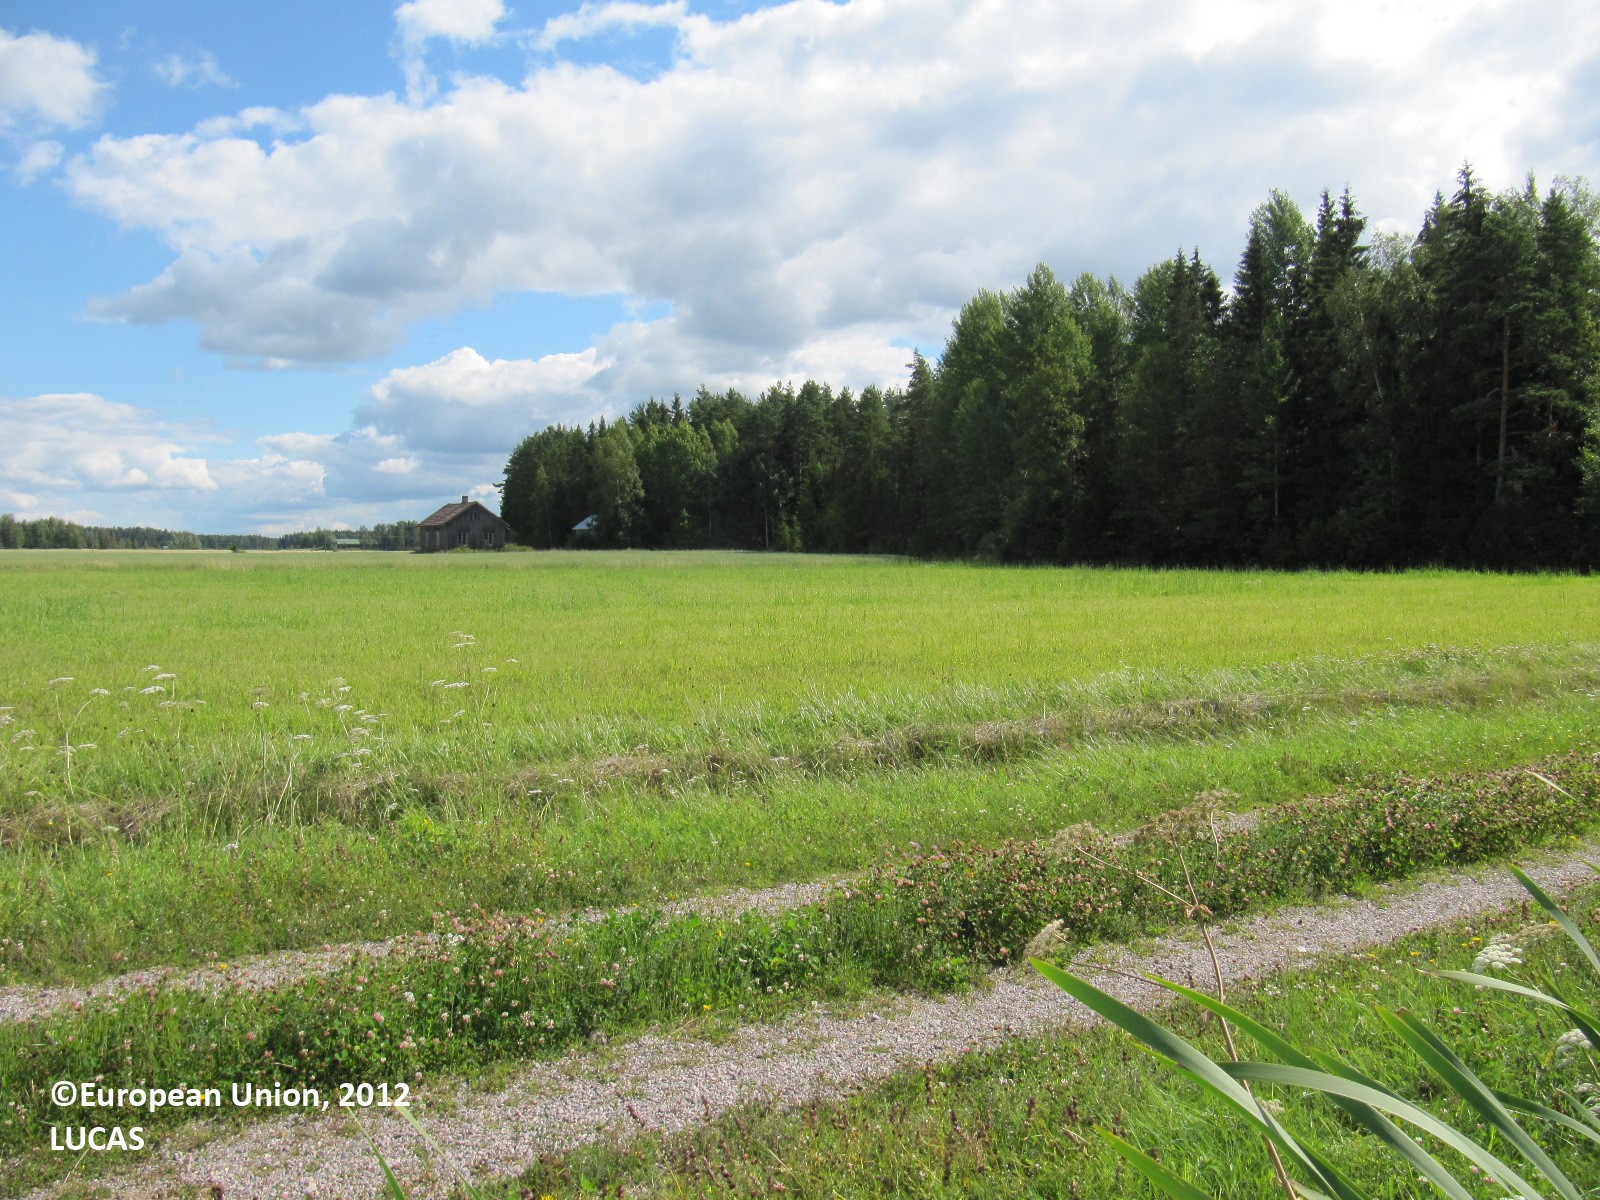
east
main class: Cropland
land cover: Barley
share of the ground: > 75 %
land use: Agriculture (excluding fallow land and kitchen gardens)
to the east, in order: Barley; Electric lines; Barley; Grass margins; Ditches and canals; Grass margins; Tracks; Grass margins; Ditches and canals; Grassland without tree/shrub cover; Ditches and canals; Broadleaved woodland; Pine dominated mixed woodland
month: August
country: FI
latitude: 60.5632
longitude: 23.1962
